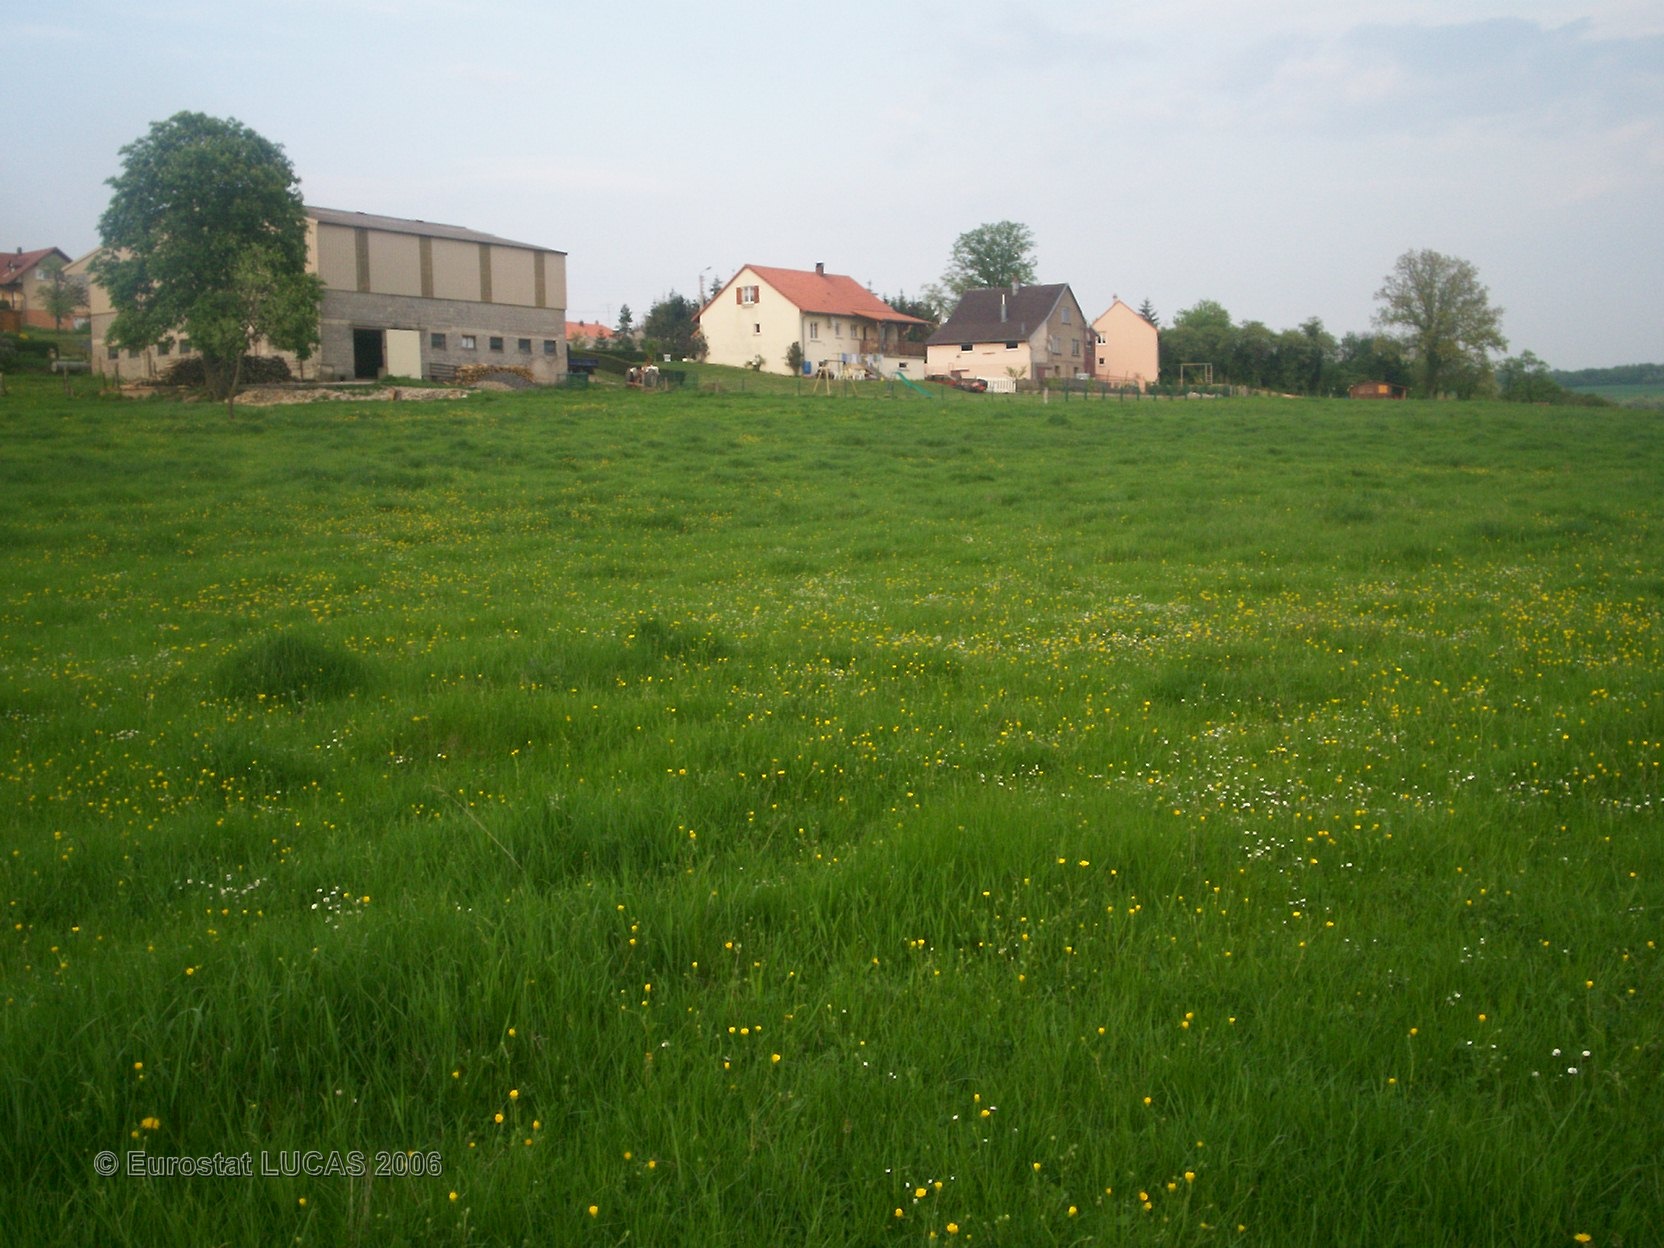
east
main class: Grassland
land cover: Grassland without tree/shrub cover
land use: Agriculture (excluding fallow land and kitchen gardens)
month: May
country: FR
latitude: 48.7588
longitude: 6.9943
